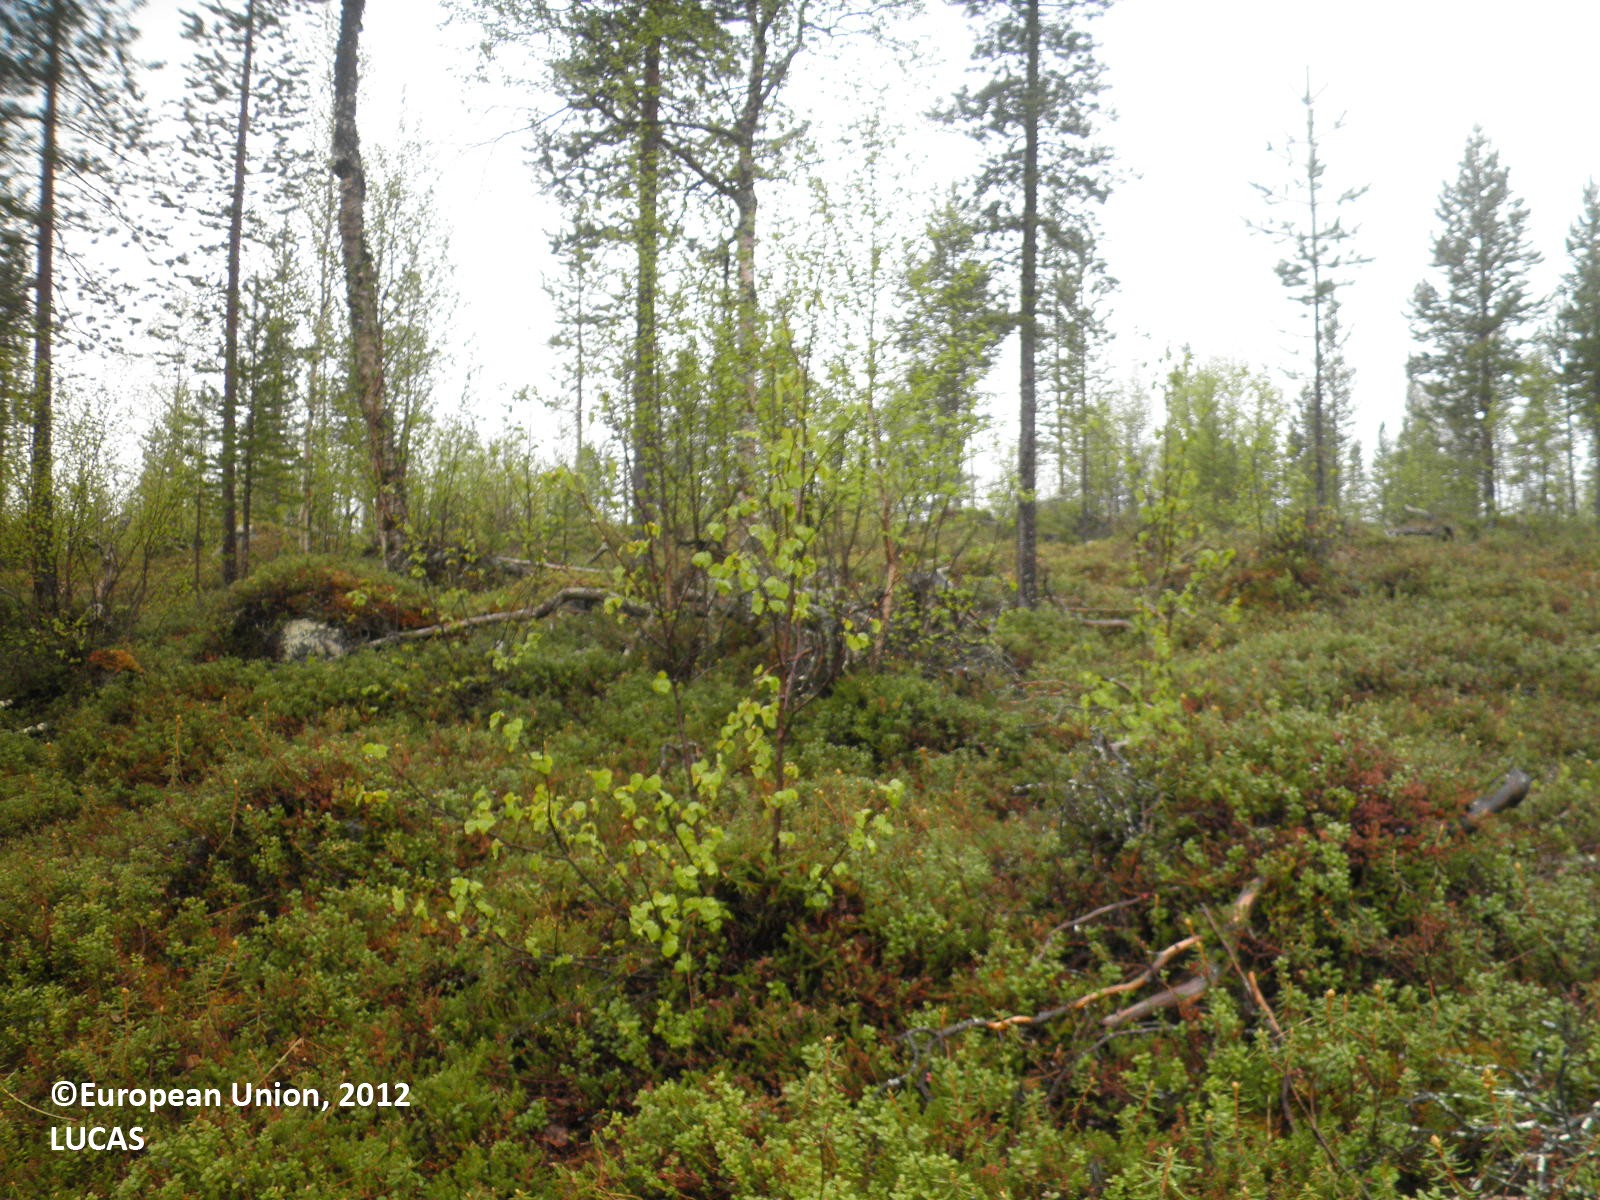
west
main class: Woodland
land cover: Pine dominated mixed woodland
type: boreal forest
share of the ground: 25 - 50 %
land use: Forestry
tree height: > 5 m
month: June
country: FI
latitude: 68.8759
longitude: 26.7879
